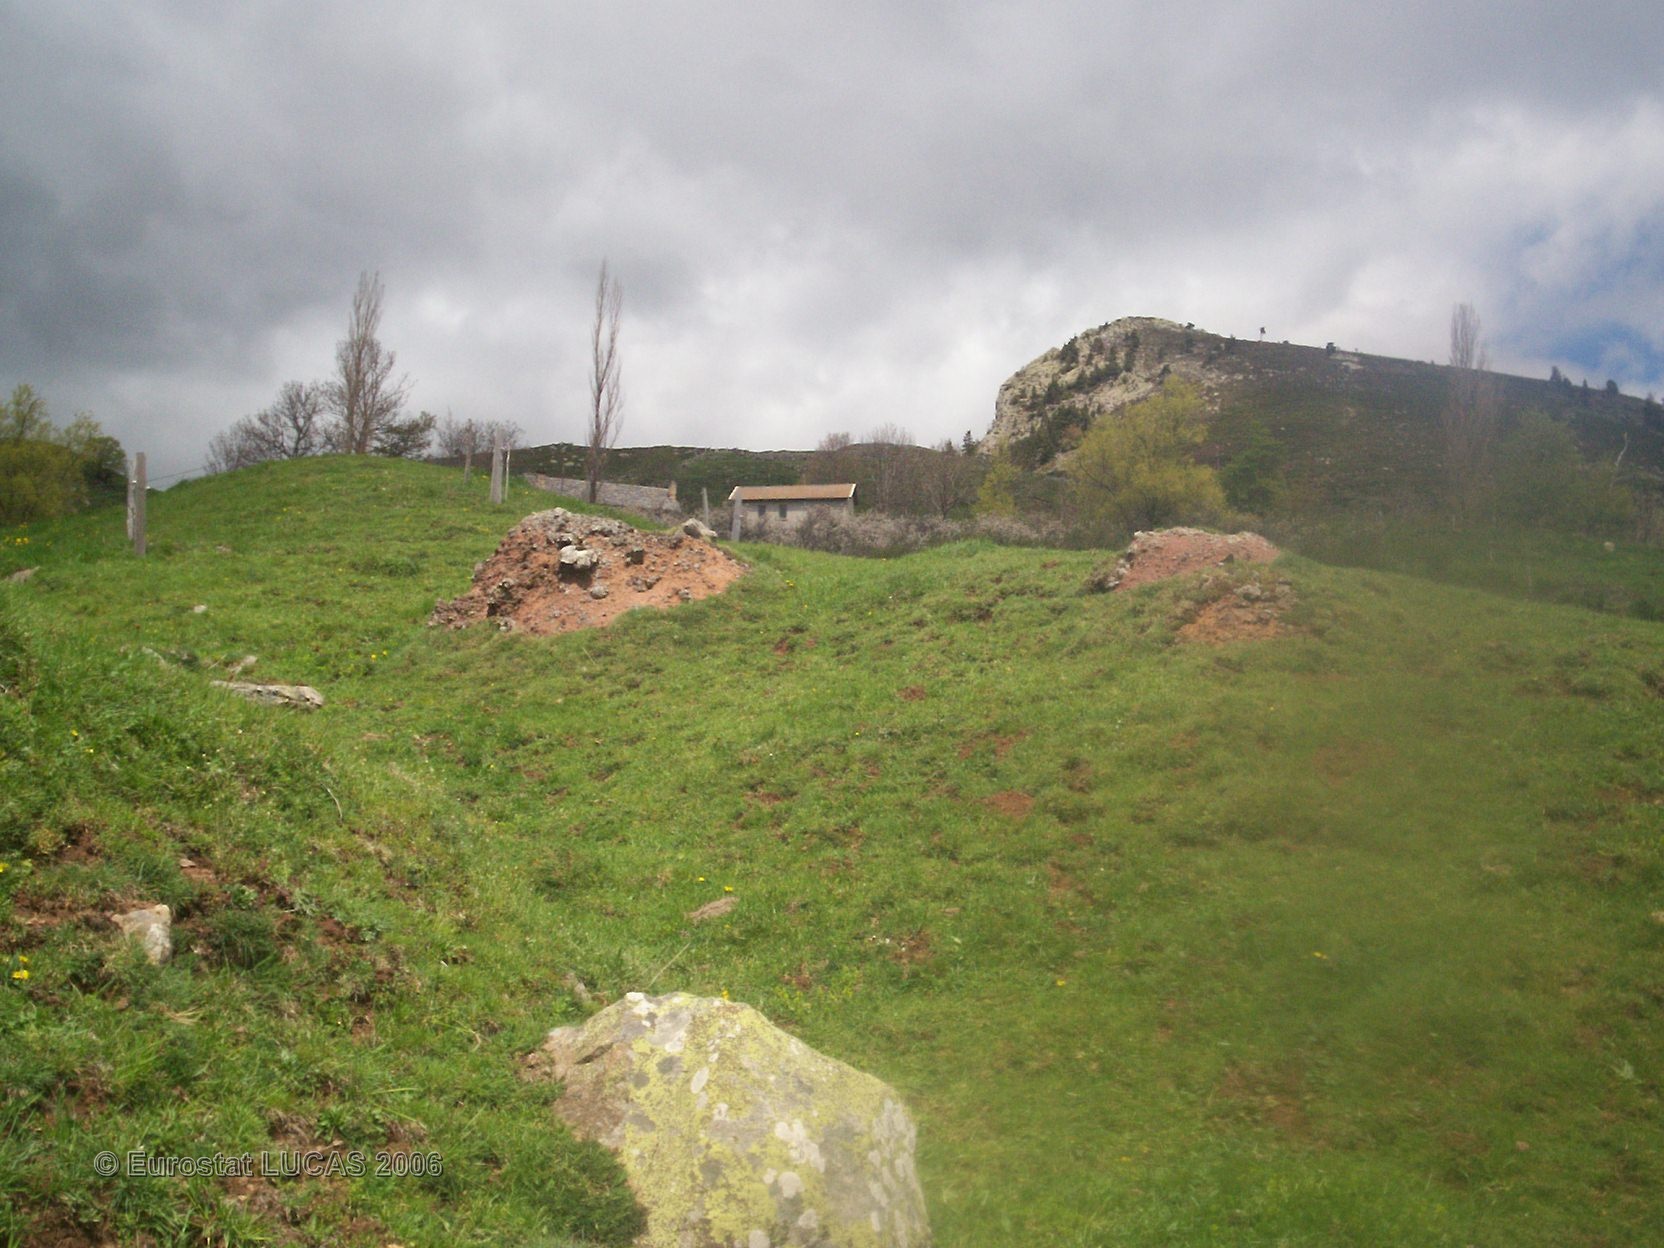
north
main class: Grassland
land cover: Grassland without tree/shrub cover
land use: Agriculture (excluding fallow land and kitchen gardens)
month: May
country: FR
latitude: 44.9122
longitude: 4.2165
